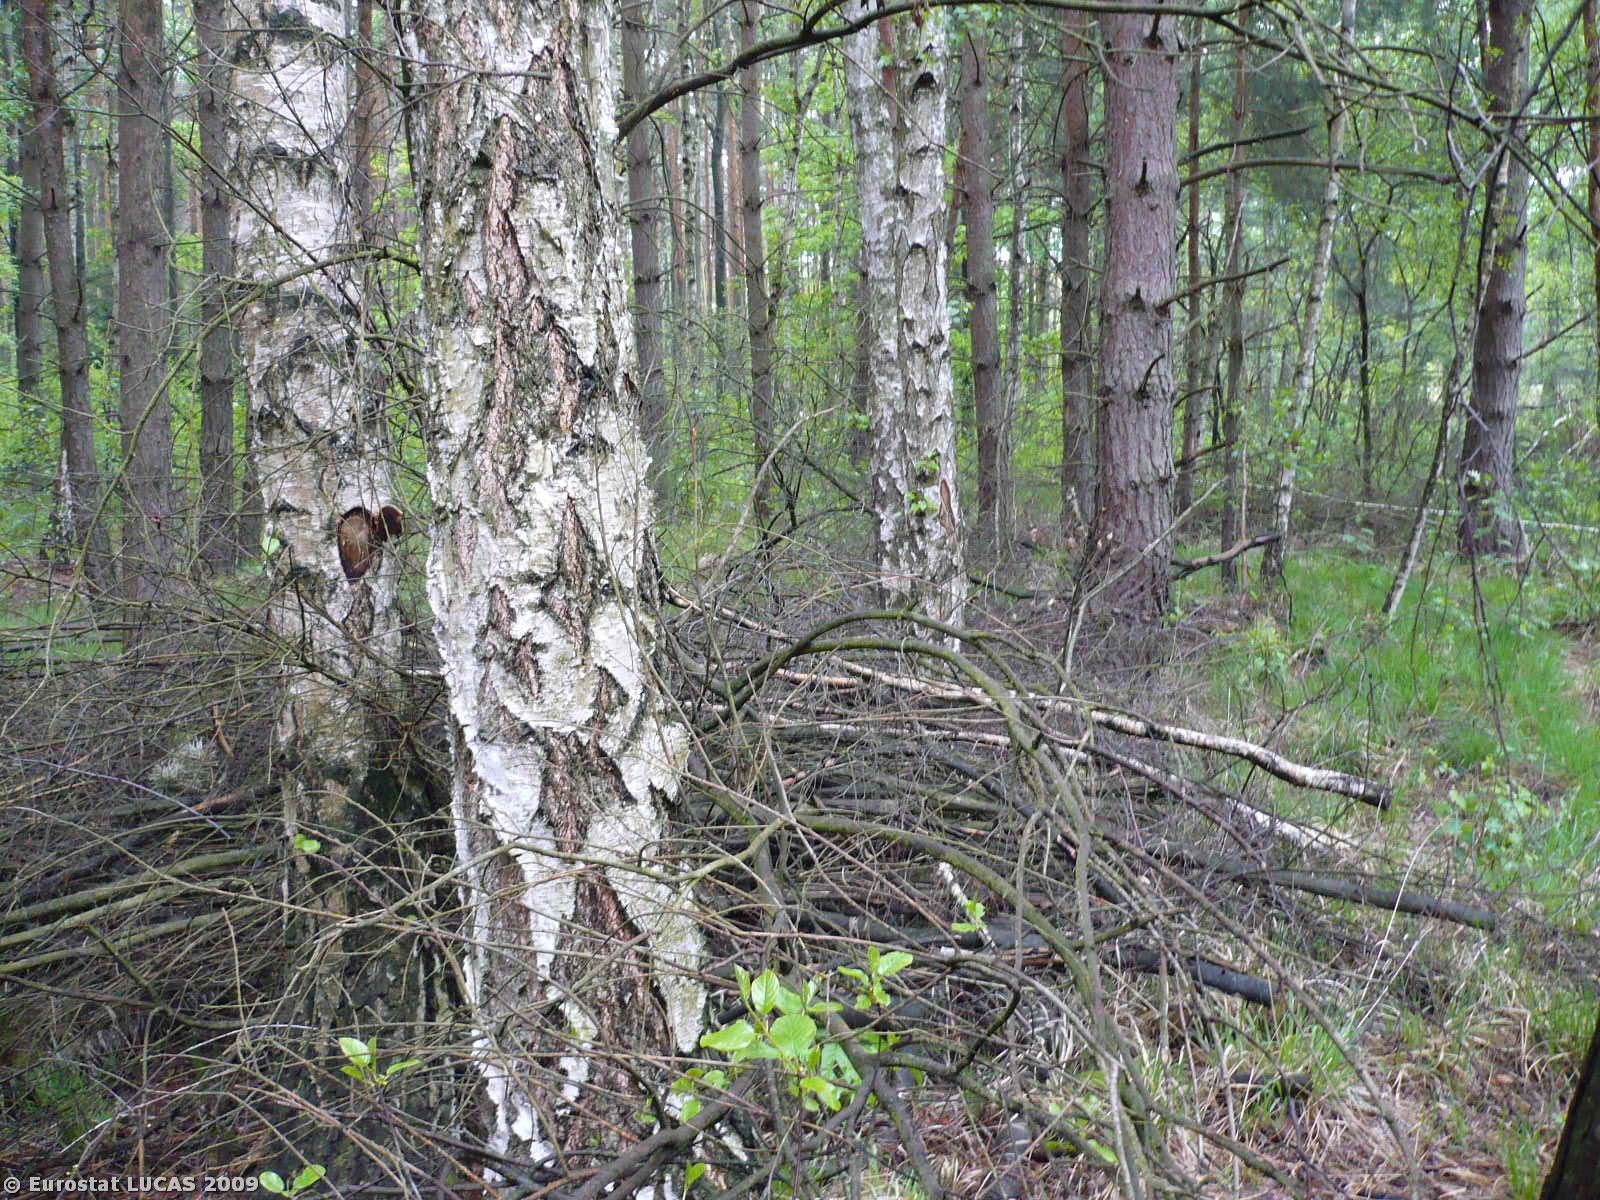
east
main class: Woodland
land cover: Coniferous woodland
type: hemiboreal forest and nemoral coniferous forest and mixed broadleaved-coniferous forest
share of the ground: > 75 %
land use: Forestry
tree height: > 5 m
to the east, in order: Coniferous woodland
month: May
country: PL
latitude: 51.9151
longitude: 15.3392
